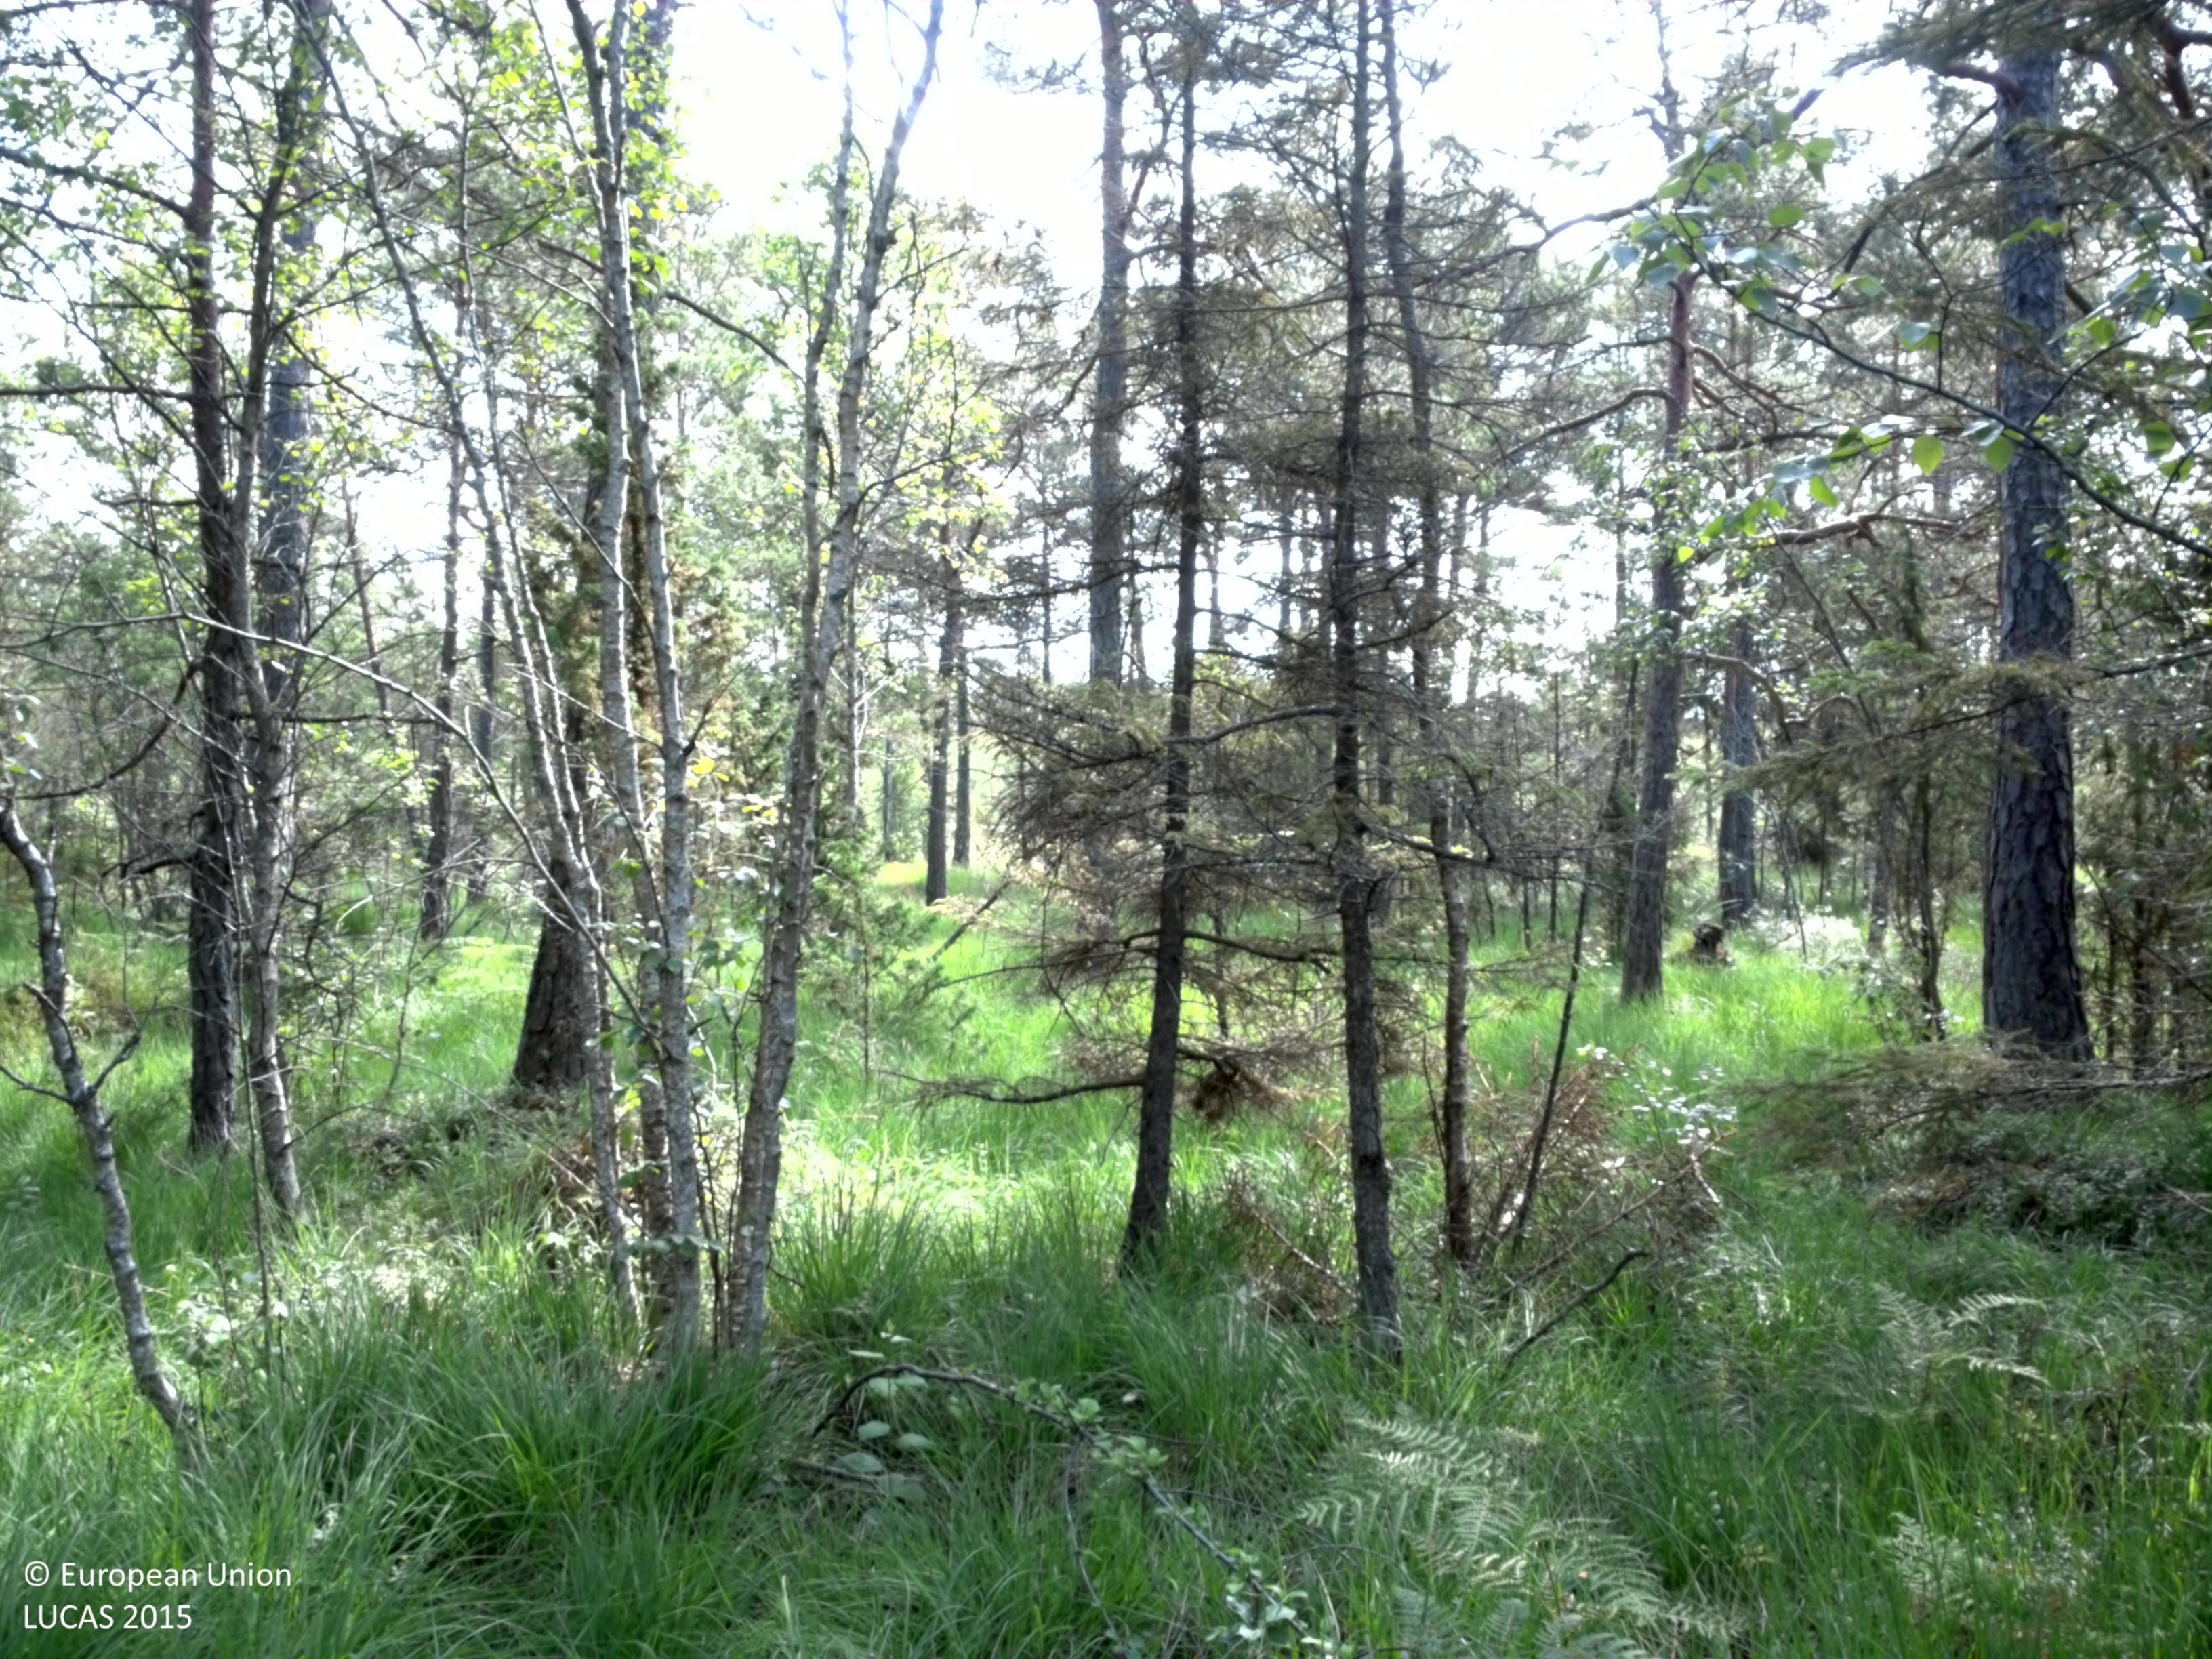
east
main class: Woodland
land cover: Pine dominated mixed woodland
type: hemiboreal forest and nemoral coniferous forest and mixed broadleaved-coniferous forest
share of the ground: 50 - 75 %
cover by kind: herbaceous plants 40 %, coniferous forest trees 35 %, broadleaved forest trees 20 %, shrubs 5 %
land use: Forestry
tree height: > 5 m
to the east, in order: Pine dominated mixed woodland; Pine dominated coniferous woodland; Paved roads, cycling and walking lanes; Pine dominated mixed woodland
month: July
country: SE
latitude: 57.3932
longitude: 18.7125
